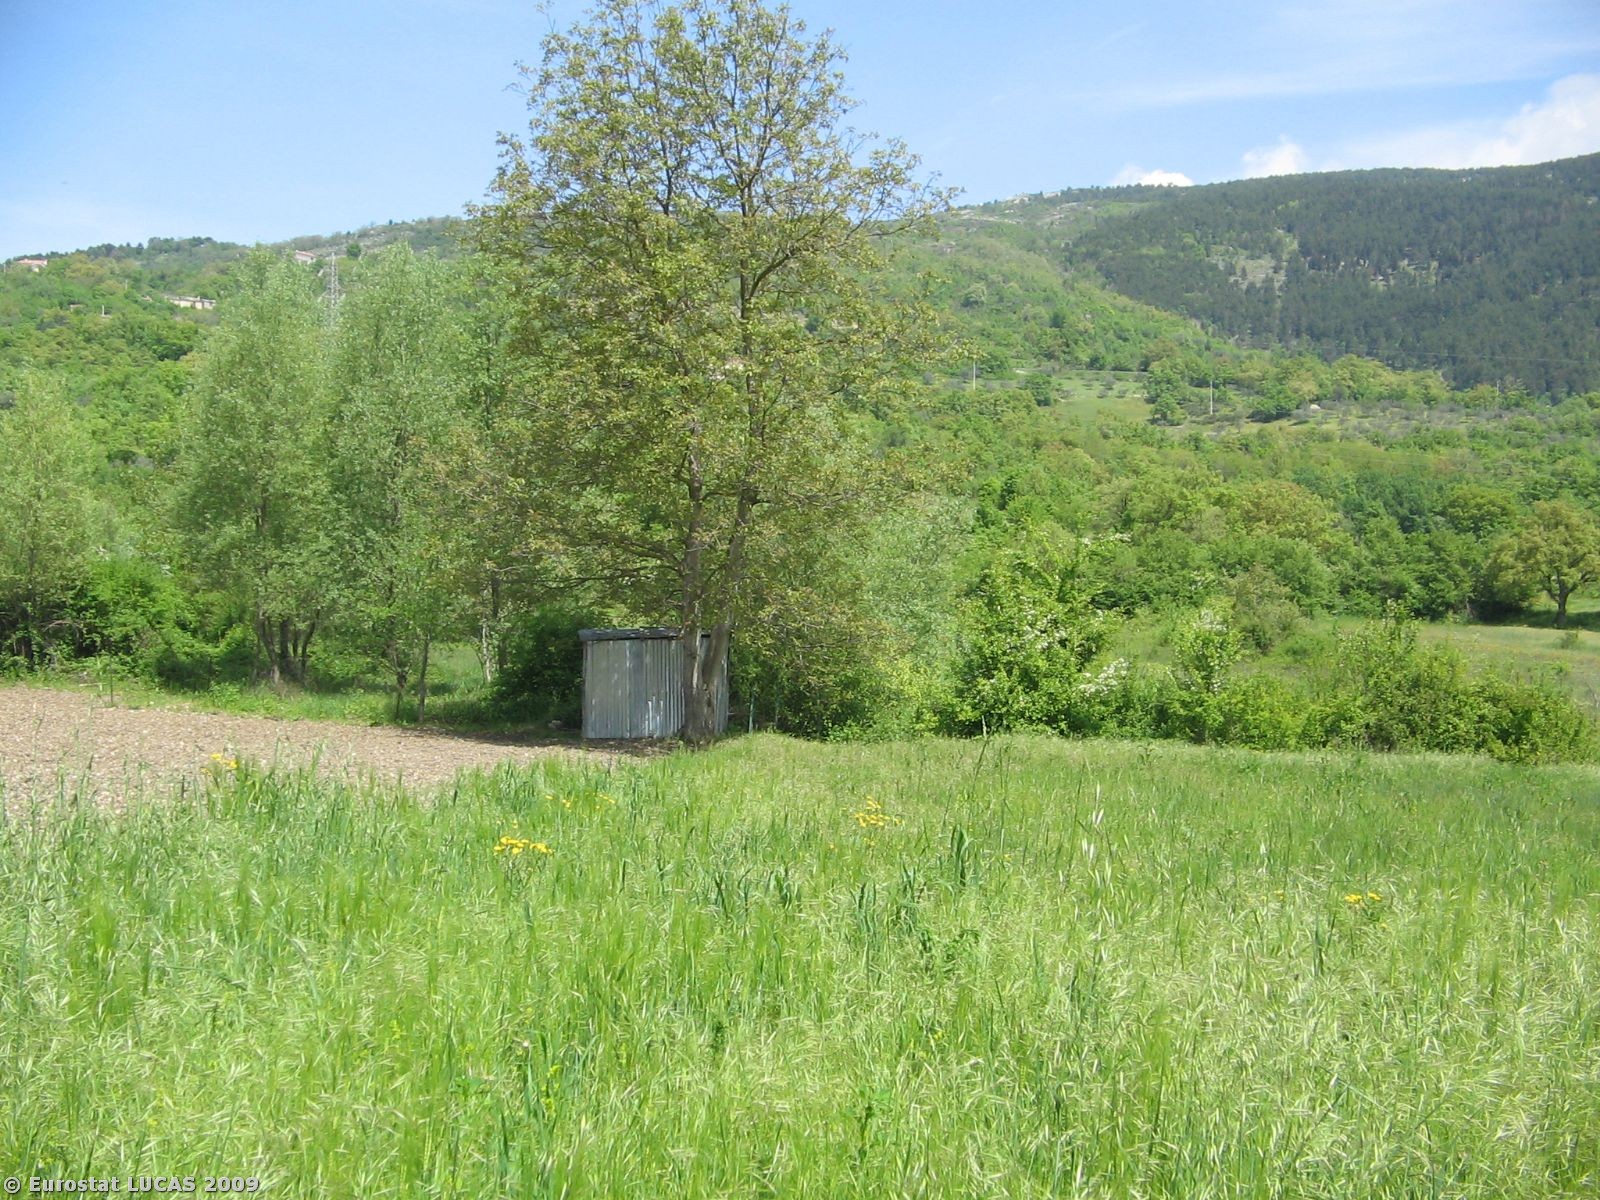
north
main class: Cropland
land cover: Temporary grasslands
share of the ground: > 75 %
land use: Agriculture (excluding fallow land and kitchen gardens)
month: May
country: IT
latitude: 41.5470
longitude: 14.3600
